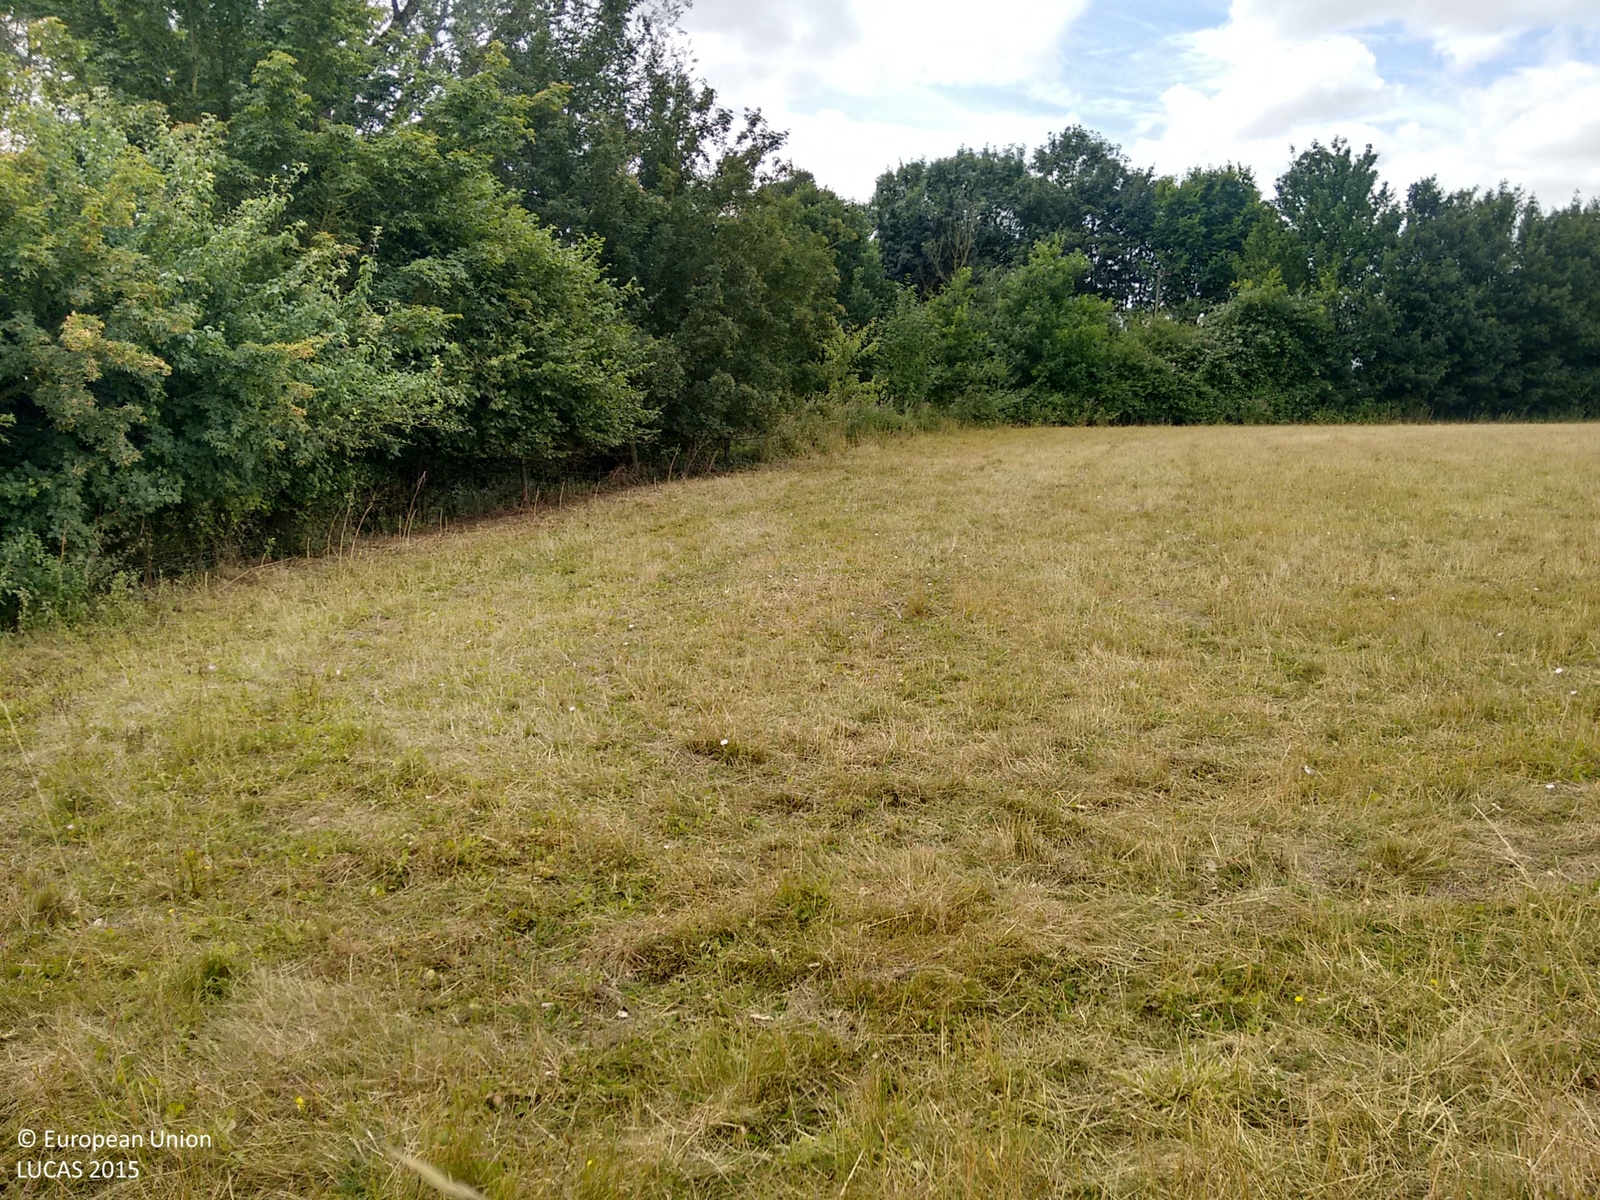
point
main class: Grassland
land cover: Grassland without tree/shrub cover
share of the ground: > 75 %
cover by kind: herbaceous plants 100 %
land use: Agriculture (excluding fallow land and kitchen gardens)
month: August
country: GB
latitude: 51.9678
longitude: 0.3791
